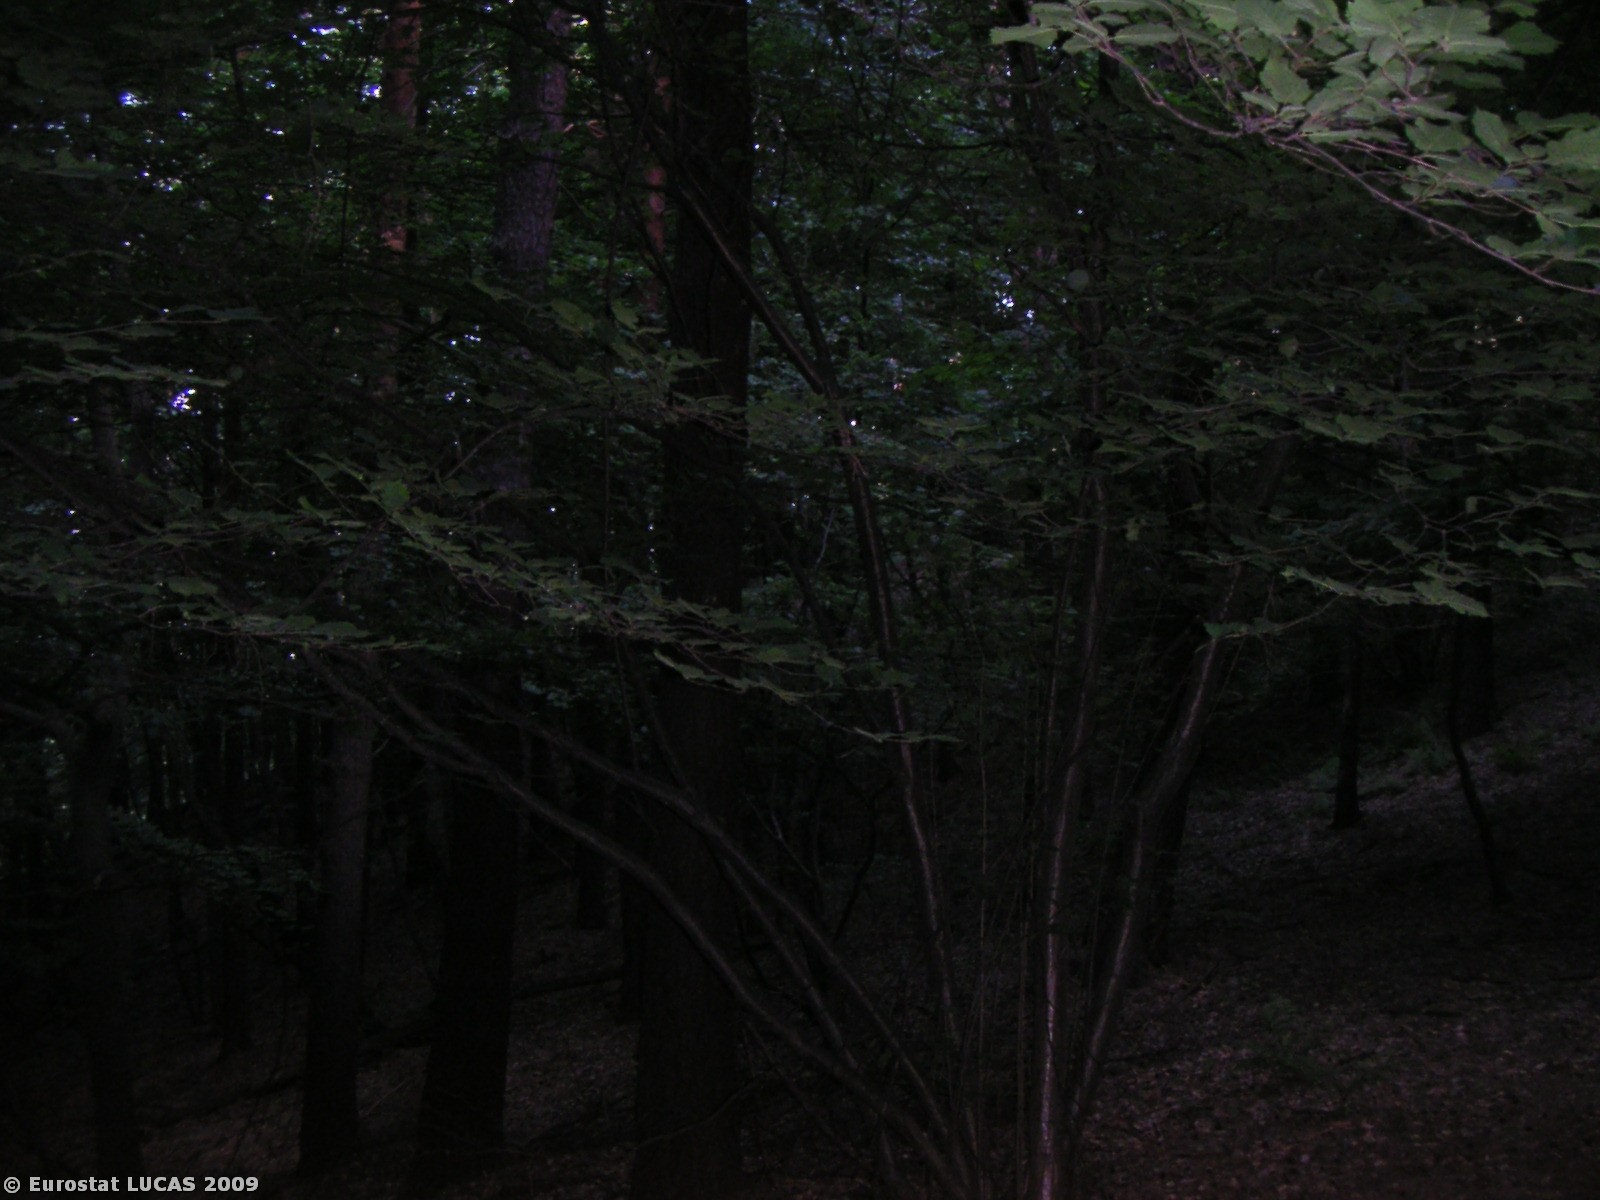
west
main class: Woodland
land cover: Mixed woodland
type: hemiboreal forest and nemoral coniferous forest and mixed broadleaved-coniferous forest
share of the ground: > 75 %
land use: Forestry
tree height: > 5 m
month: June
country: PL
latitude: 50.1098
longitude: 19.7479
